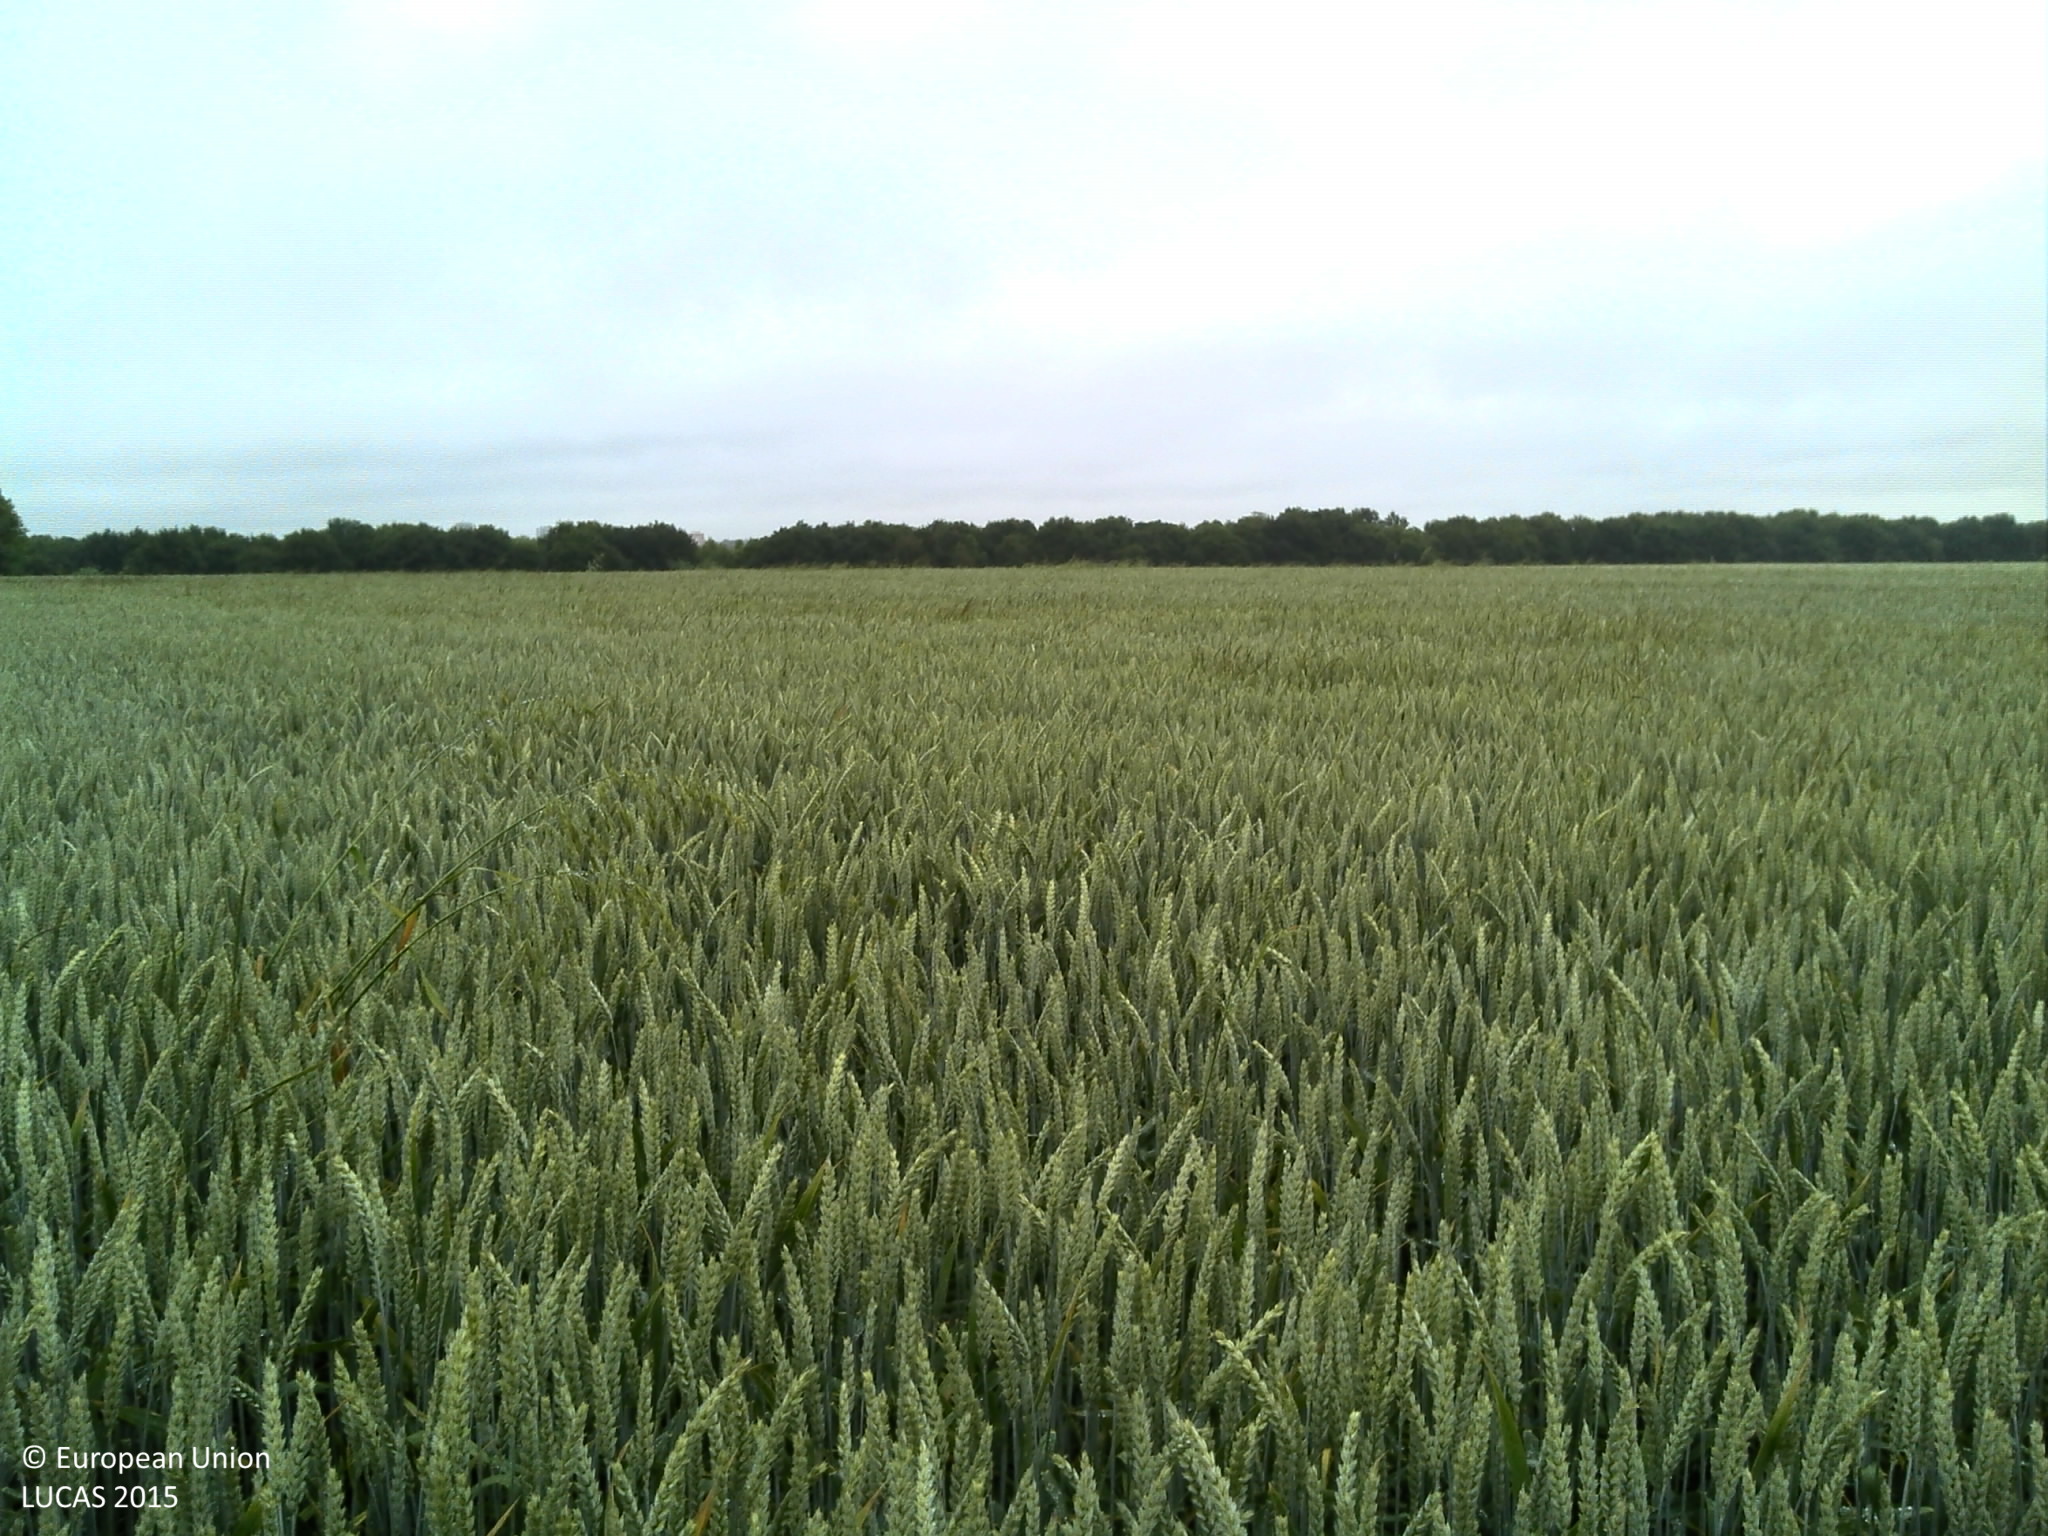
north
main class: Cropland
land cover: Common wheat
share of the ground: > 75 %
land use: Agriculture (excluding fallow land and kitchen gardens)
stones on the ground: 10 - 25 %
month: June
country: FR
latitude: 49.4228
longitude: 1.1419
